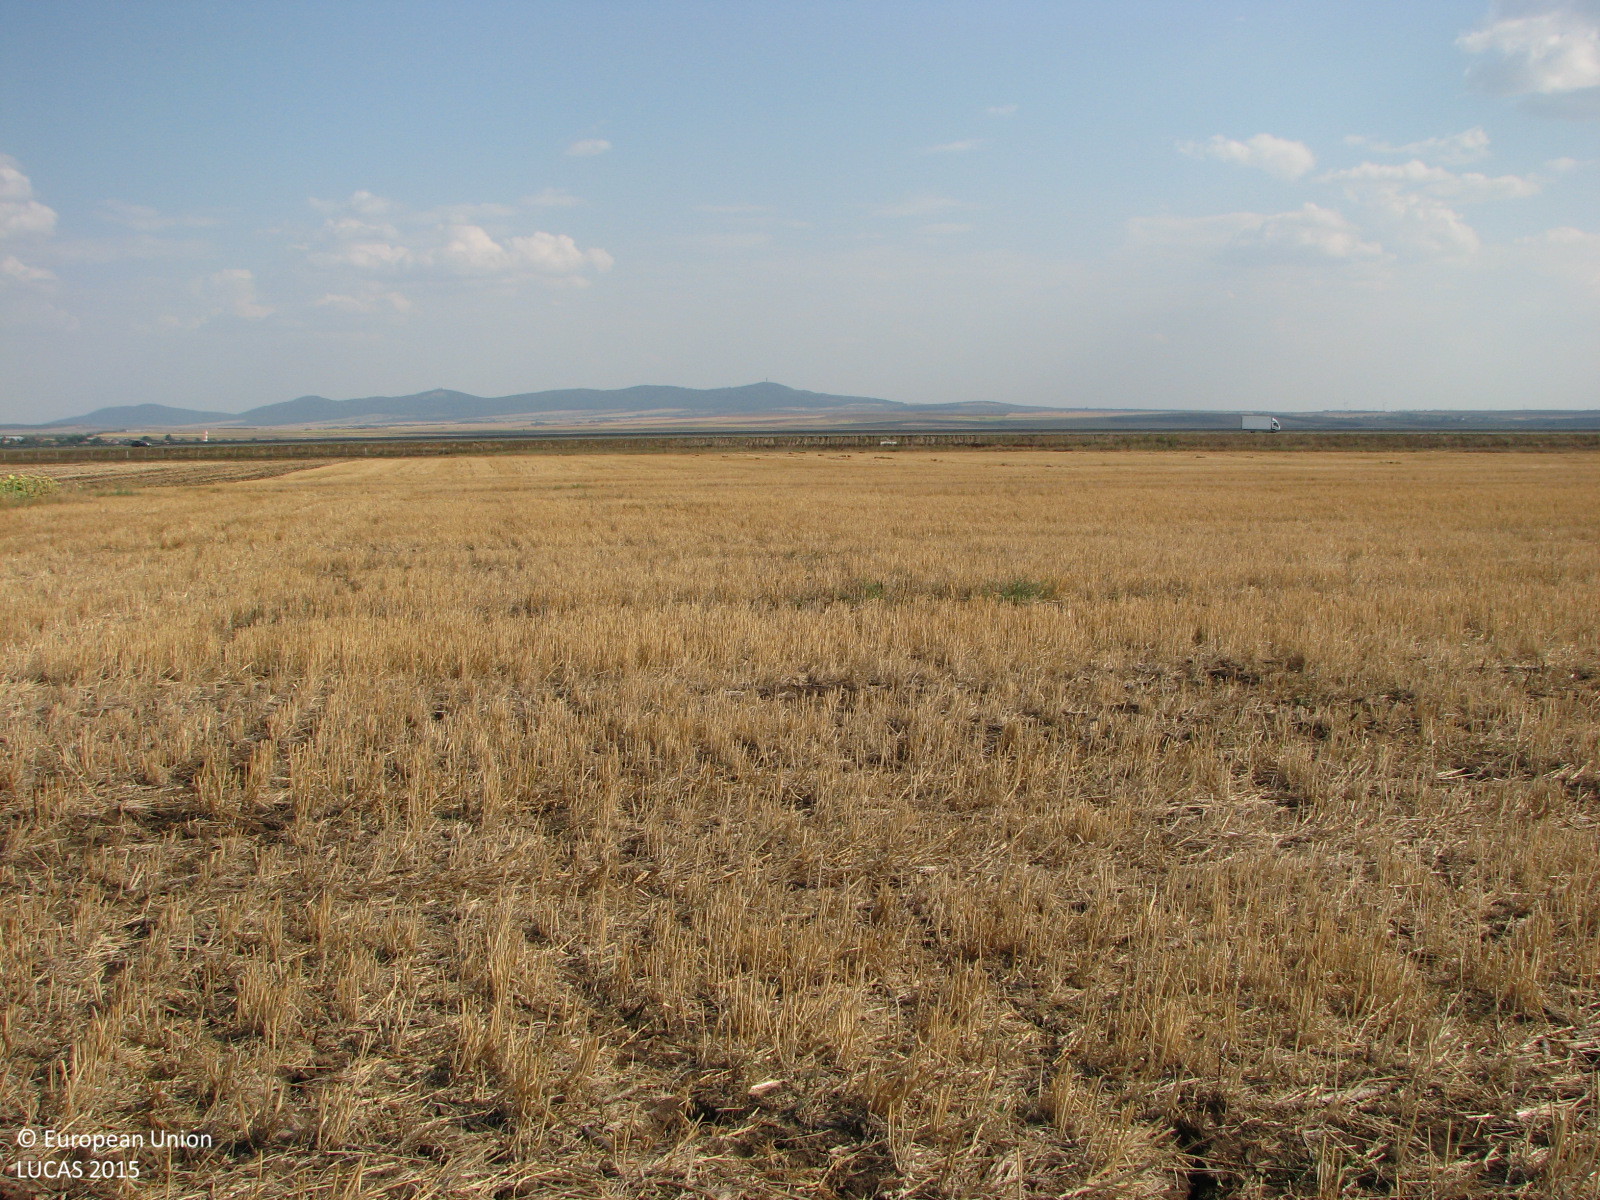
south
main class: Cropland
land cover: Common wheat
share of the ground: 25 - 50 %
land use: Agriculture (excluding fallow land and kitchen gardens)
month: August
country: BG
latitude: 42.5608
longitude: 26.5998
